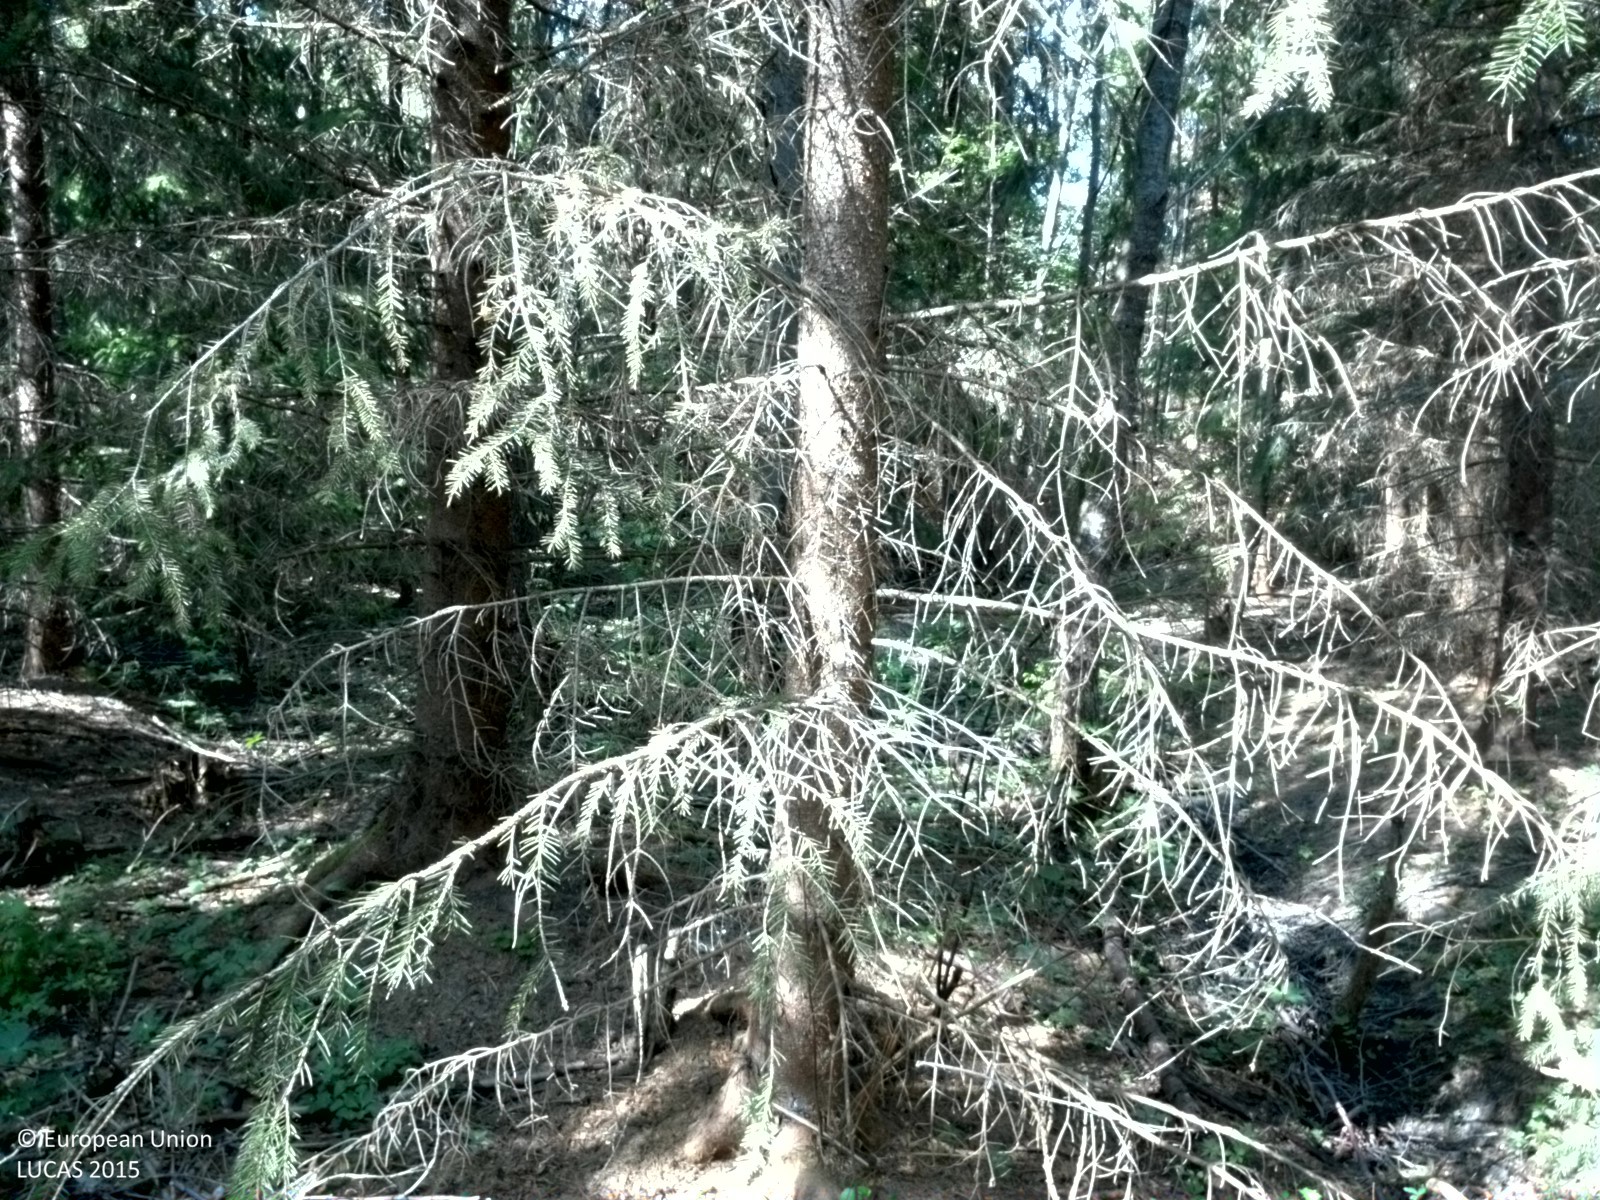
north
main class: Woodland
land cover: Spruce dominated mixed woodland
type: boreal forest
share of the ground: > 75 %
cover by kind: coniferous forest trees 55 %, broadleaved forest trees 20 %, herbaceous plants 10 %, consolidated bare surface 10 %, shrubs 5 %
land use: Forestry
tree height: > 5 m
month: June
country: SE
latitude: 60.2056
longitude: 17.6970
